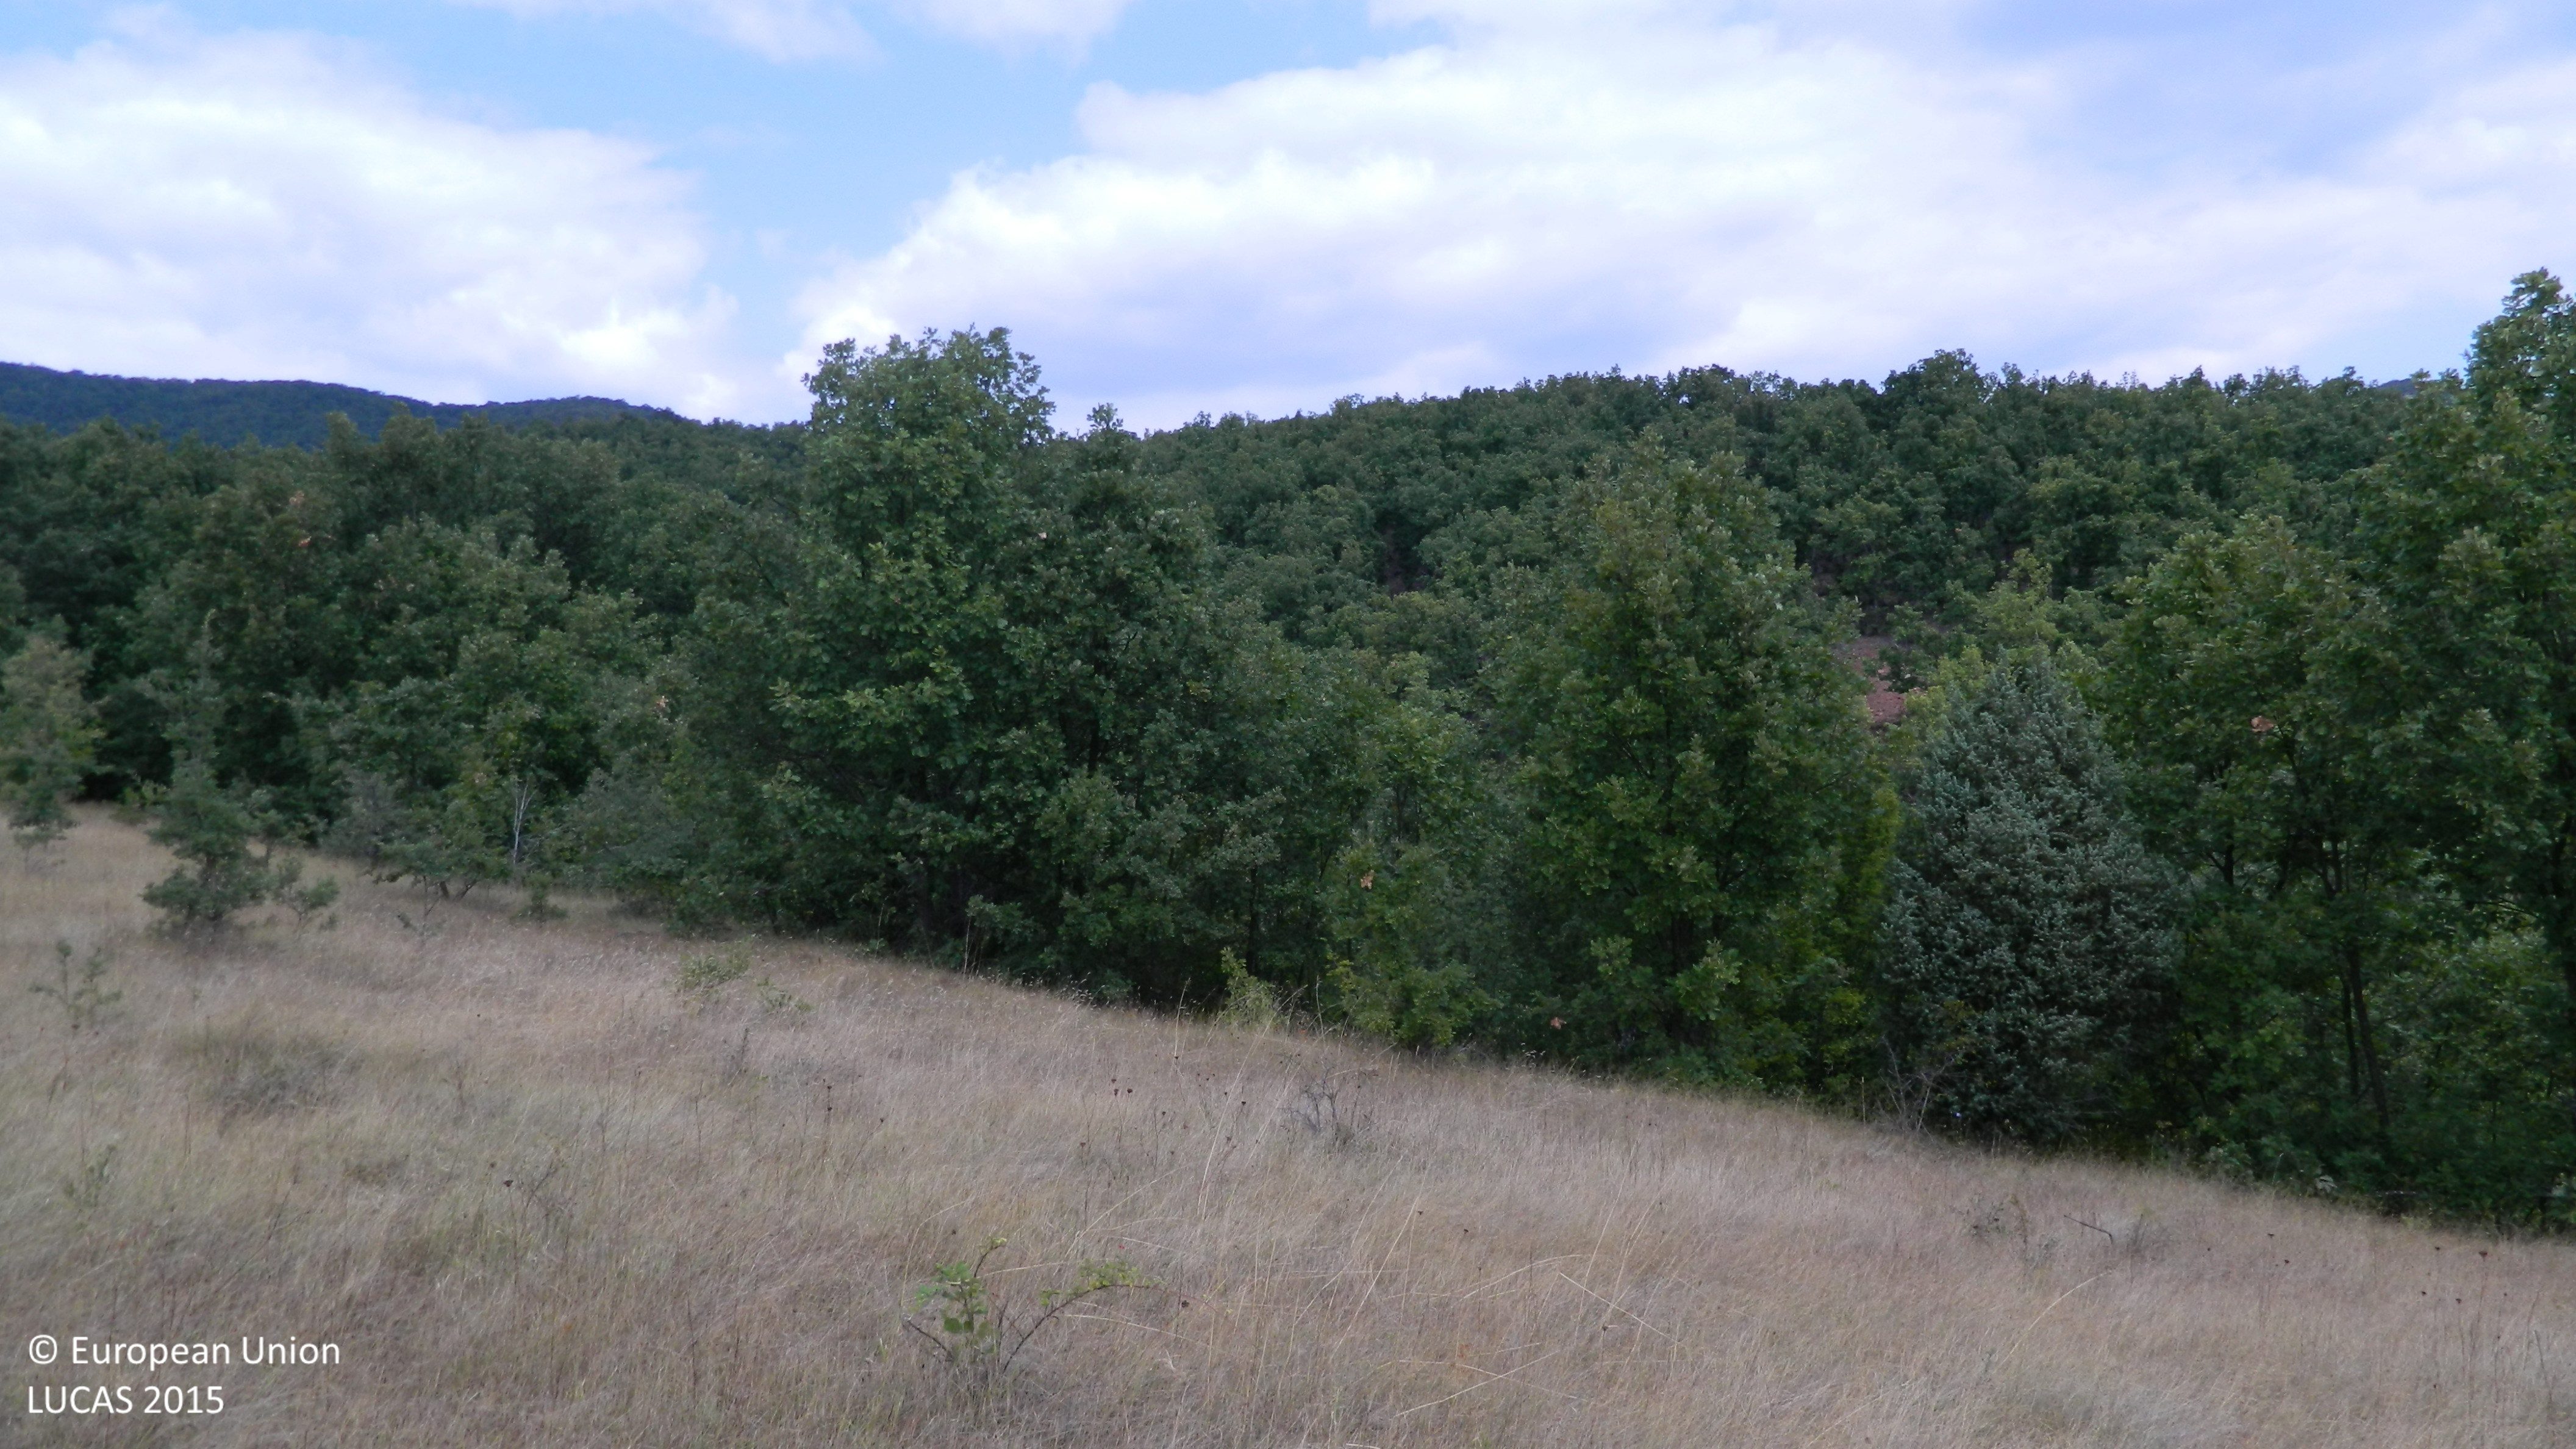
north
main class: Grassland
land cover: Grassland with sparse tree/shrub cover
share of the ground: > 75 %
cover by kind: herbaceous plants 85 %, shrubs 10 %, broadleaved forest trees 5 %
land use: Agriculture (excluding fallow land and kitchen gardens)
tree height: < 5 m
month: August
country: BG
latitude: 41.7095
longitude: 25.8474
